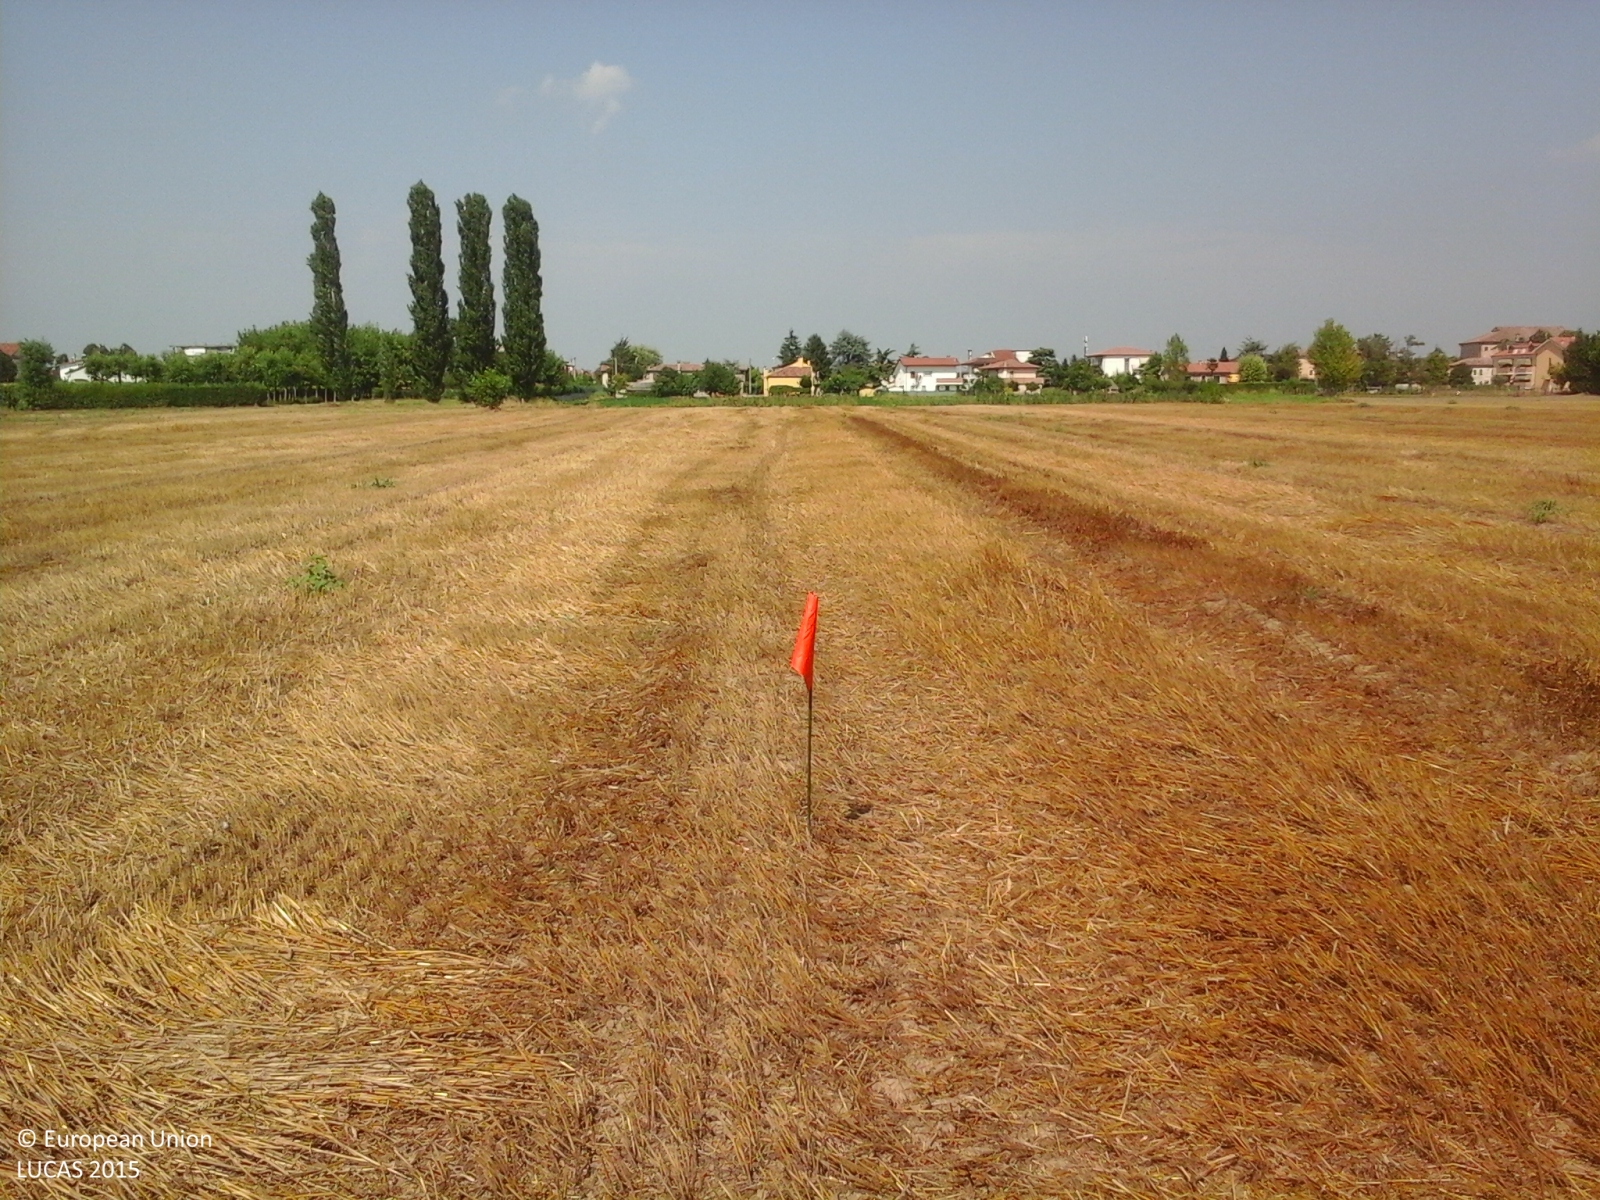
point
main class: Cropland
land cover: Common wheat
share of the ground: > 75 %
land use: Agriculture (excluding fallow land and kitchen gardens)
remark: Harvested field
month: July
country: IT
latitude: 45.2165
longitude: 11.9195
